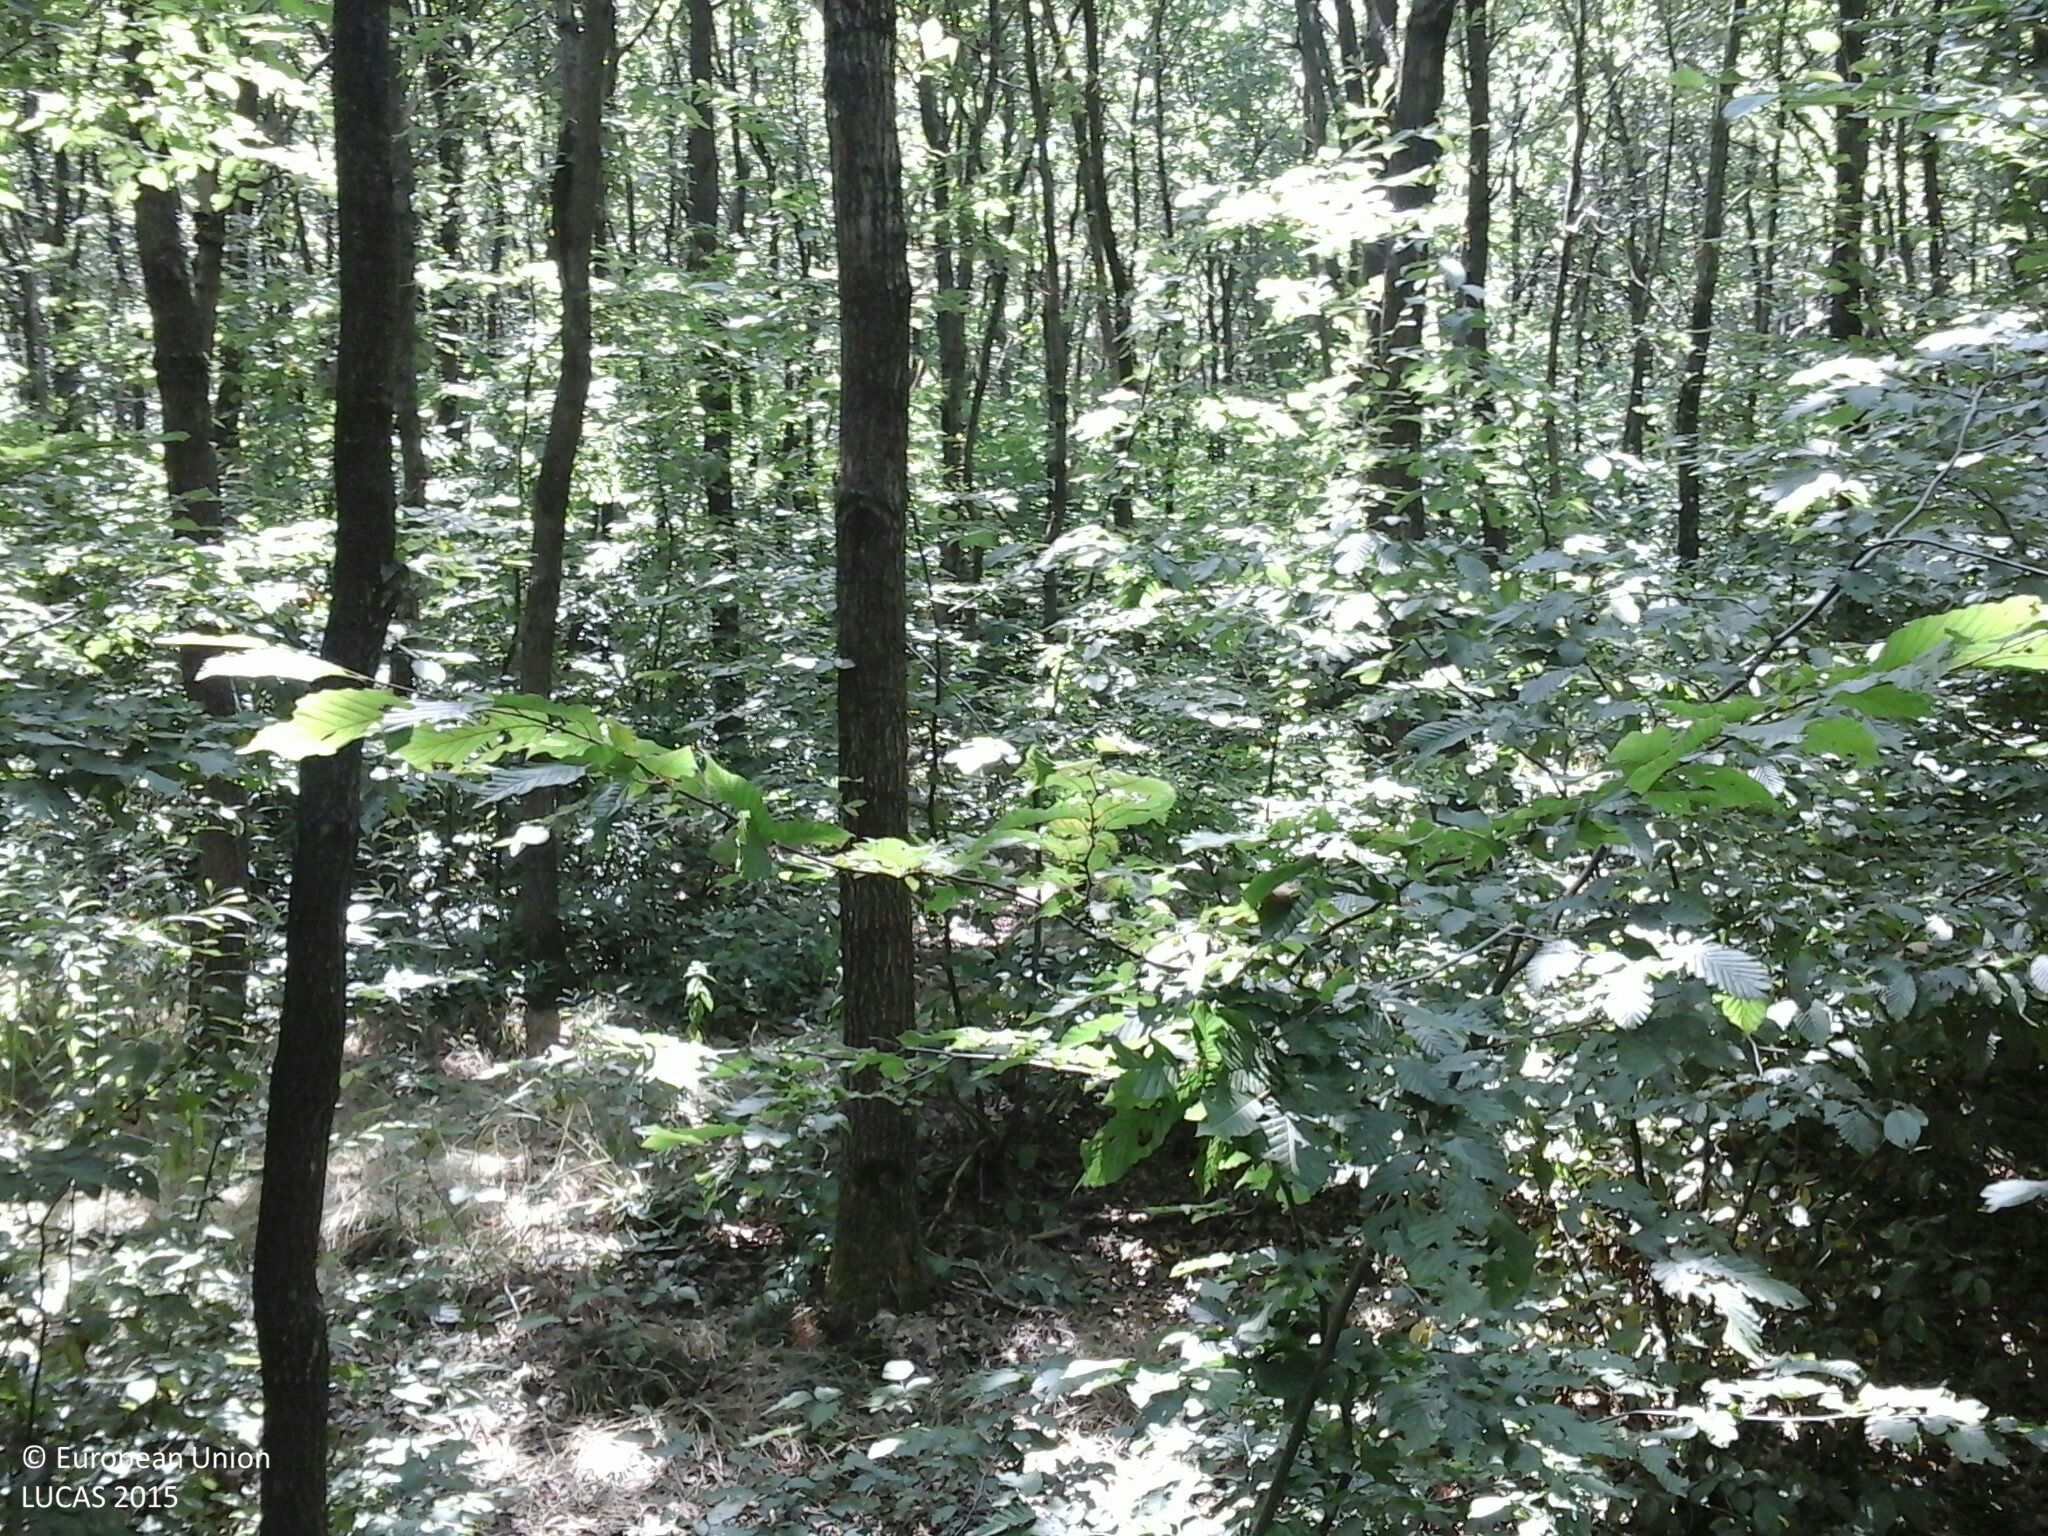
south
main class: Woodland
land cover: Broadleaved woodland
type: beech forest
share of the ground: > 75 %
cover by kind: broadleaved forest trees 75 %, coniferous forest trees 10 %, shrubs 10 %, herbaceous plants 5 %
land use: Forestry
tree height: > 5 m
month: July
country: HU
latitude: 46.9611
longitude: 16.5866
